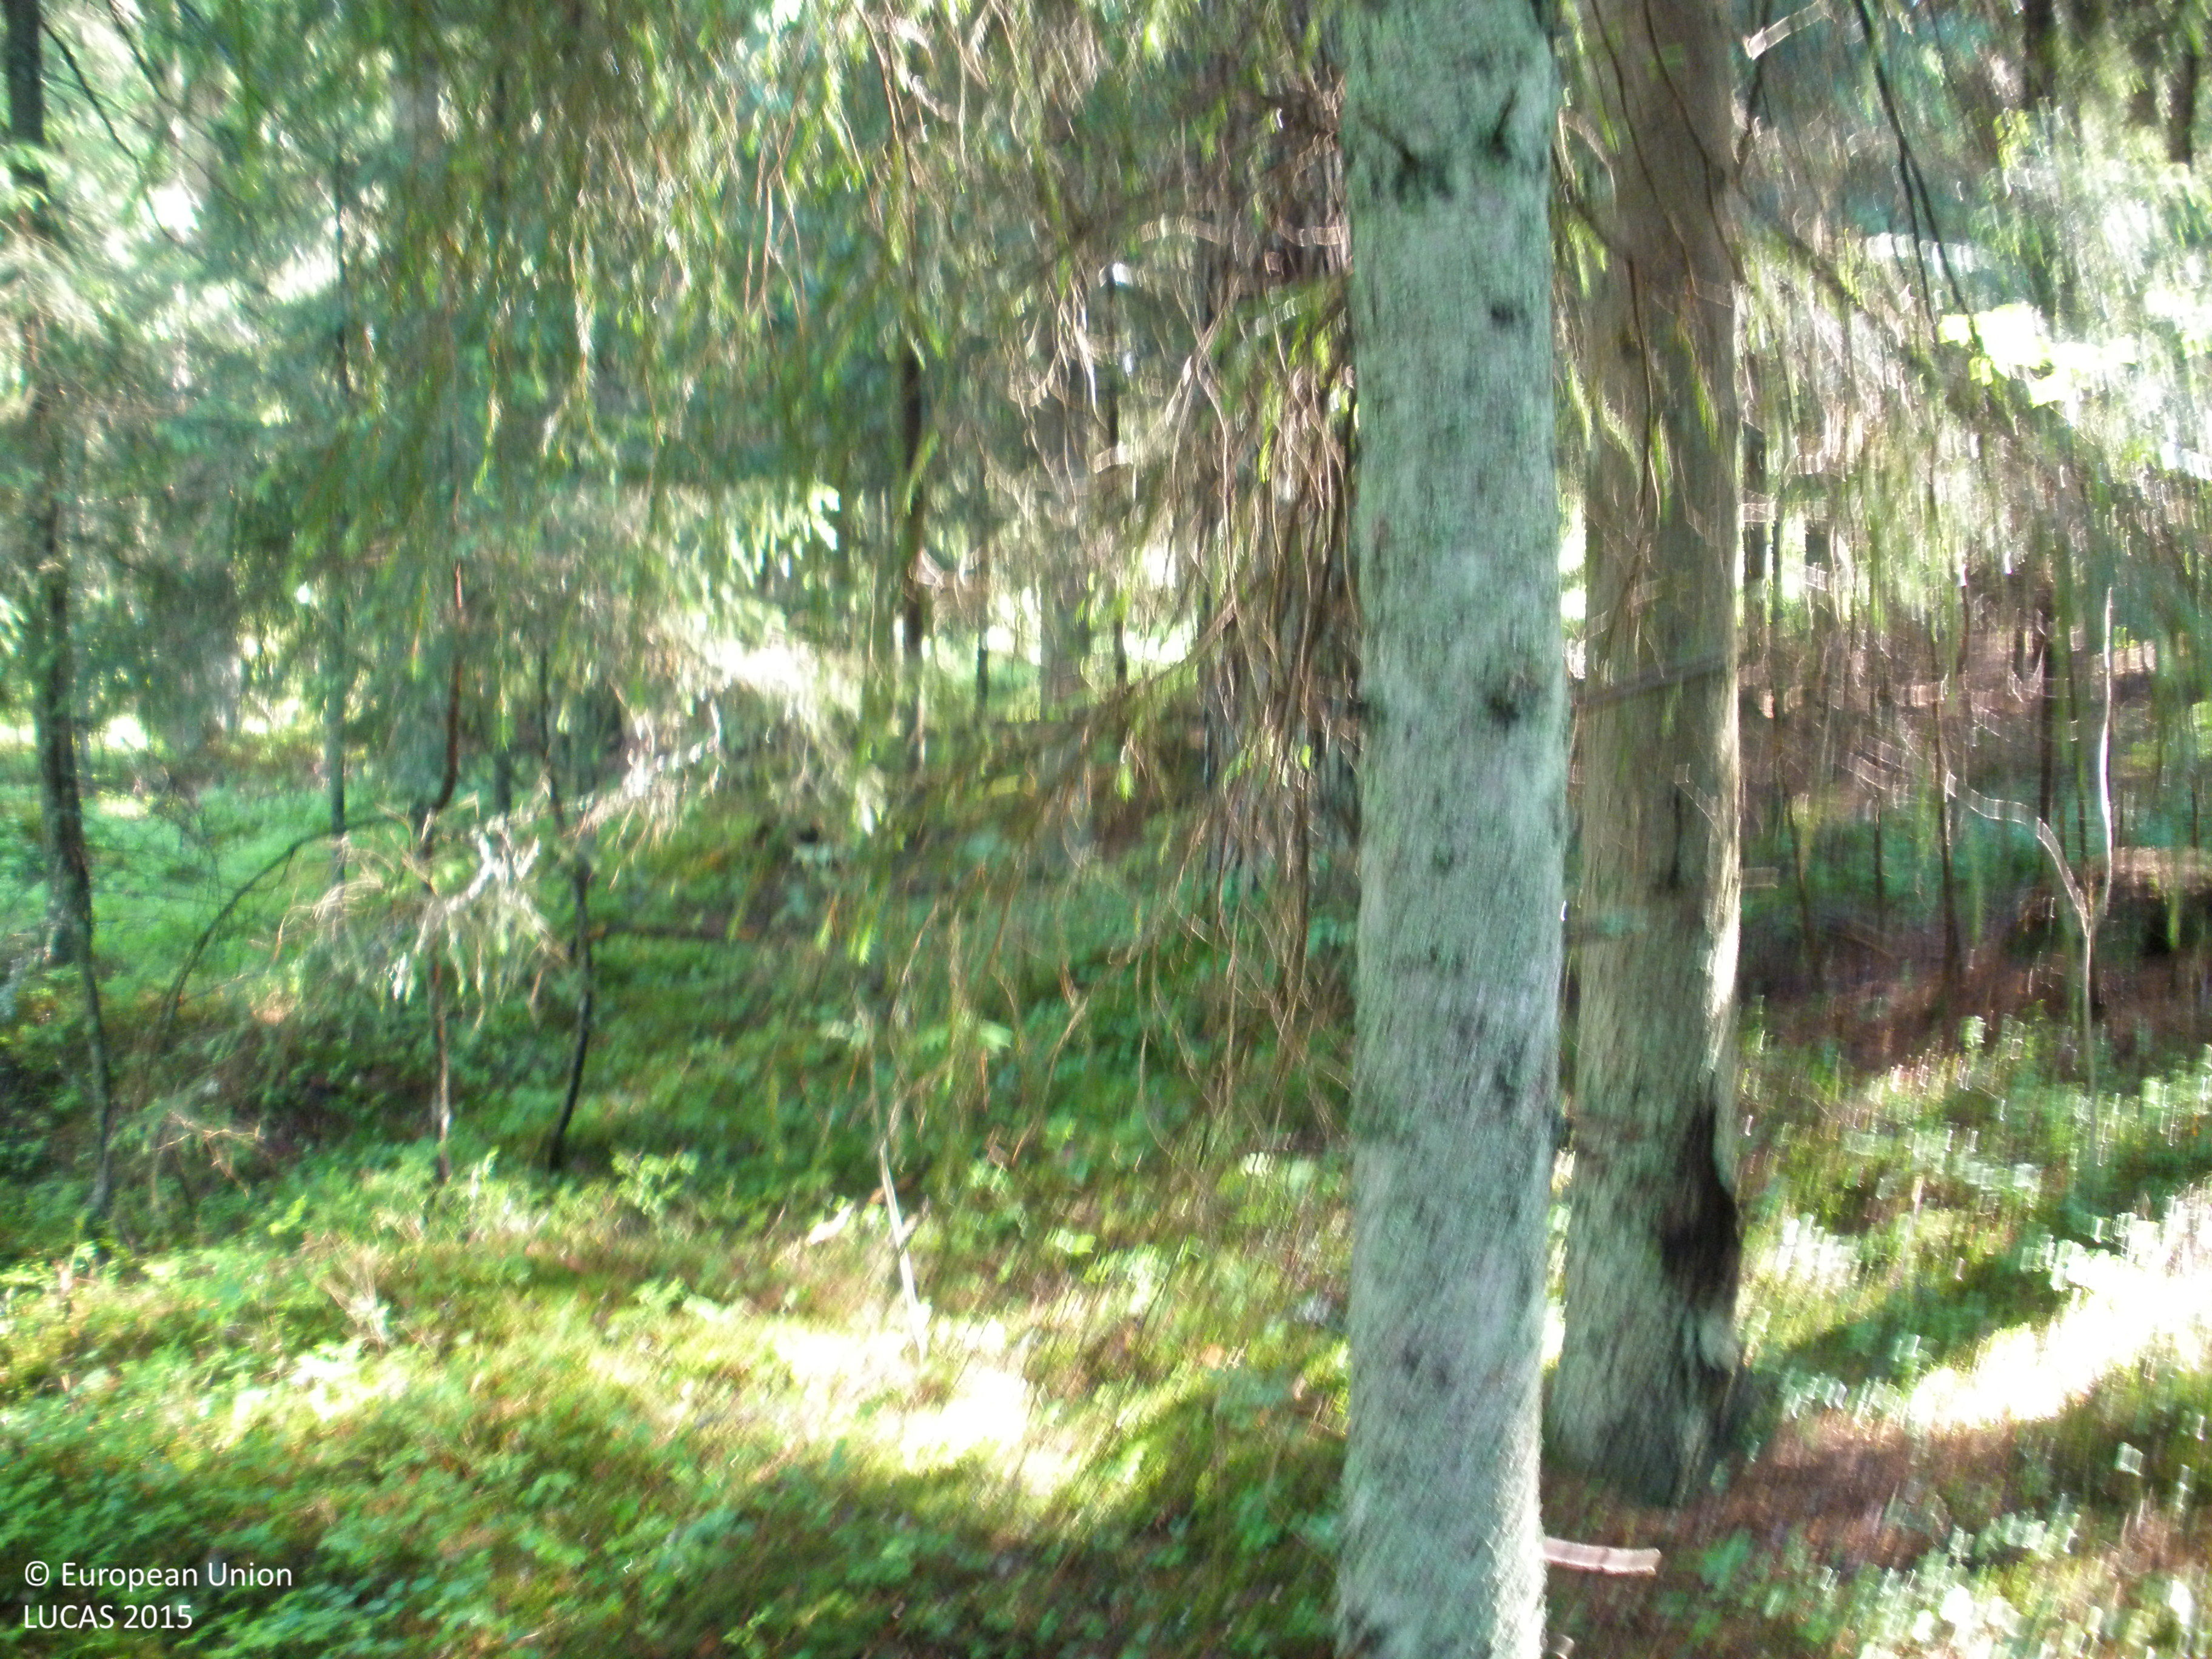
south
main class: Woodland
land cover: Spruce dominated coniferous woodland
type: boreal forest
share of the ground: > 75 %
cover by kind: coniferous forest trees 95 %, lichens and mosses 5 %
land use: Forestry
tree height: > 5 m
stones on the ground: < 10 %
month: June
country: FI
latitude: 60.9904
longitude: 23.5224
